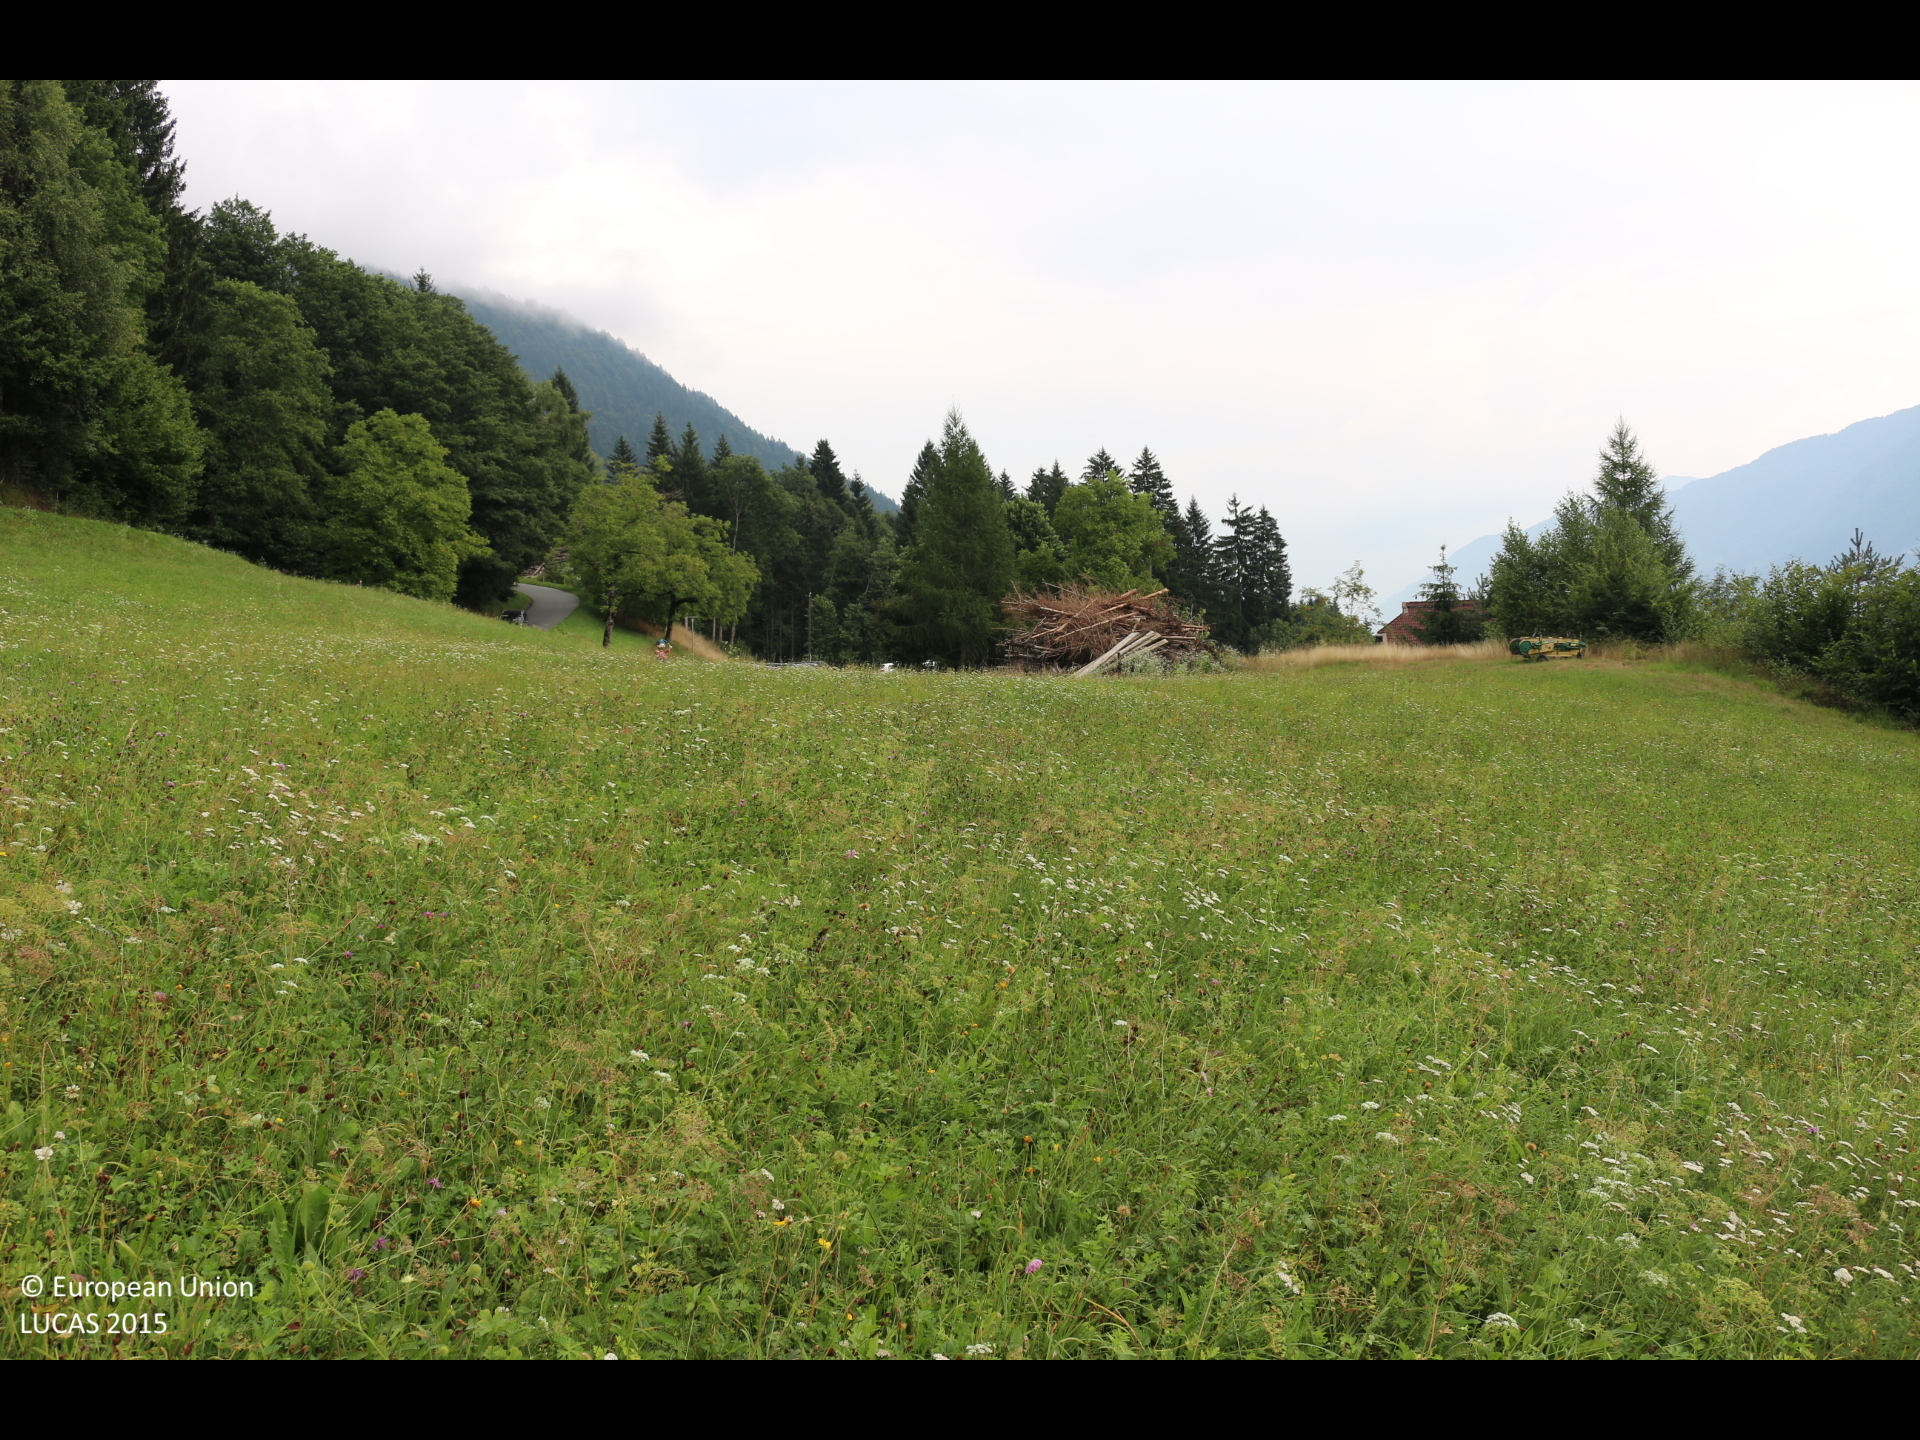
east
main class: Grassland
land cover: Grassland without tree/shrub cover
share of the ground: > 75 %
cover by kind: herbaceous plants 100 %
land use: Agriculture (excluding fallow land and kitchen gardens)
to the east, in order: Grassland without tree/shrub cover; Paved roads, cycling and walking lanes; Broadleaved woodland; Grassland without tree/shrub cover; Paved roads, cycling and walking lanes; Grassland with sparse tree/shrub cover; Tracks; Grassland without tree/shrub cover; Spruce dominated mixed woodland; Fences; Spruce dominated mixed woodland; Rivers and streams; Rocks and stones; Pine dominated mixed woodland
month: August
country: AT
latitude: 46.6247
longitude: 13.3014
